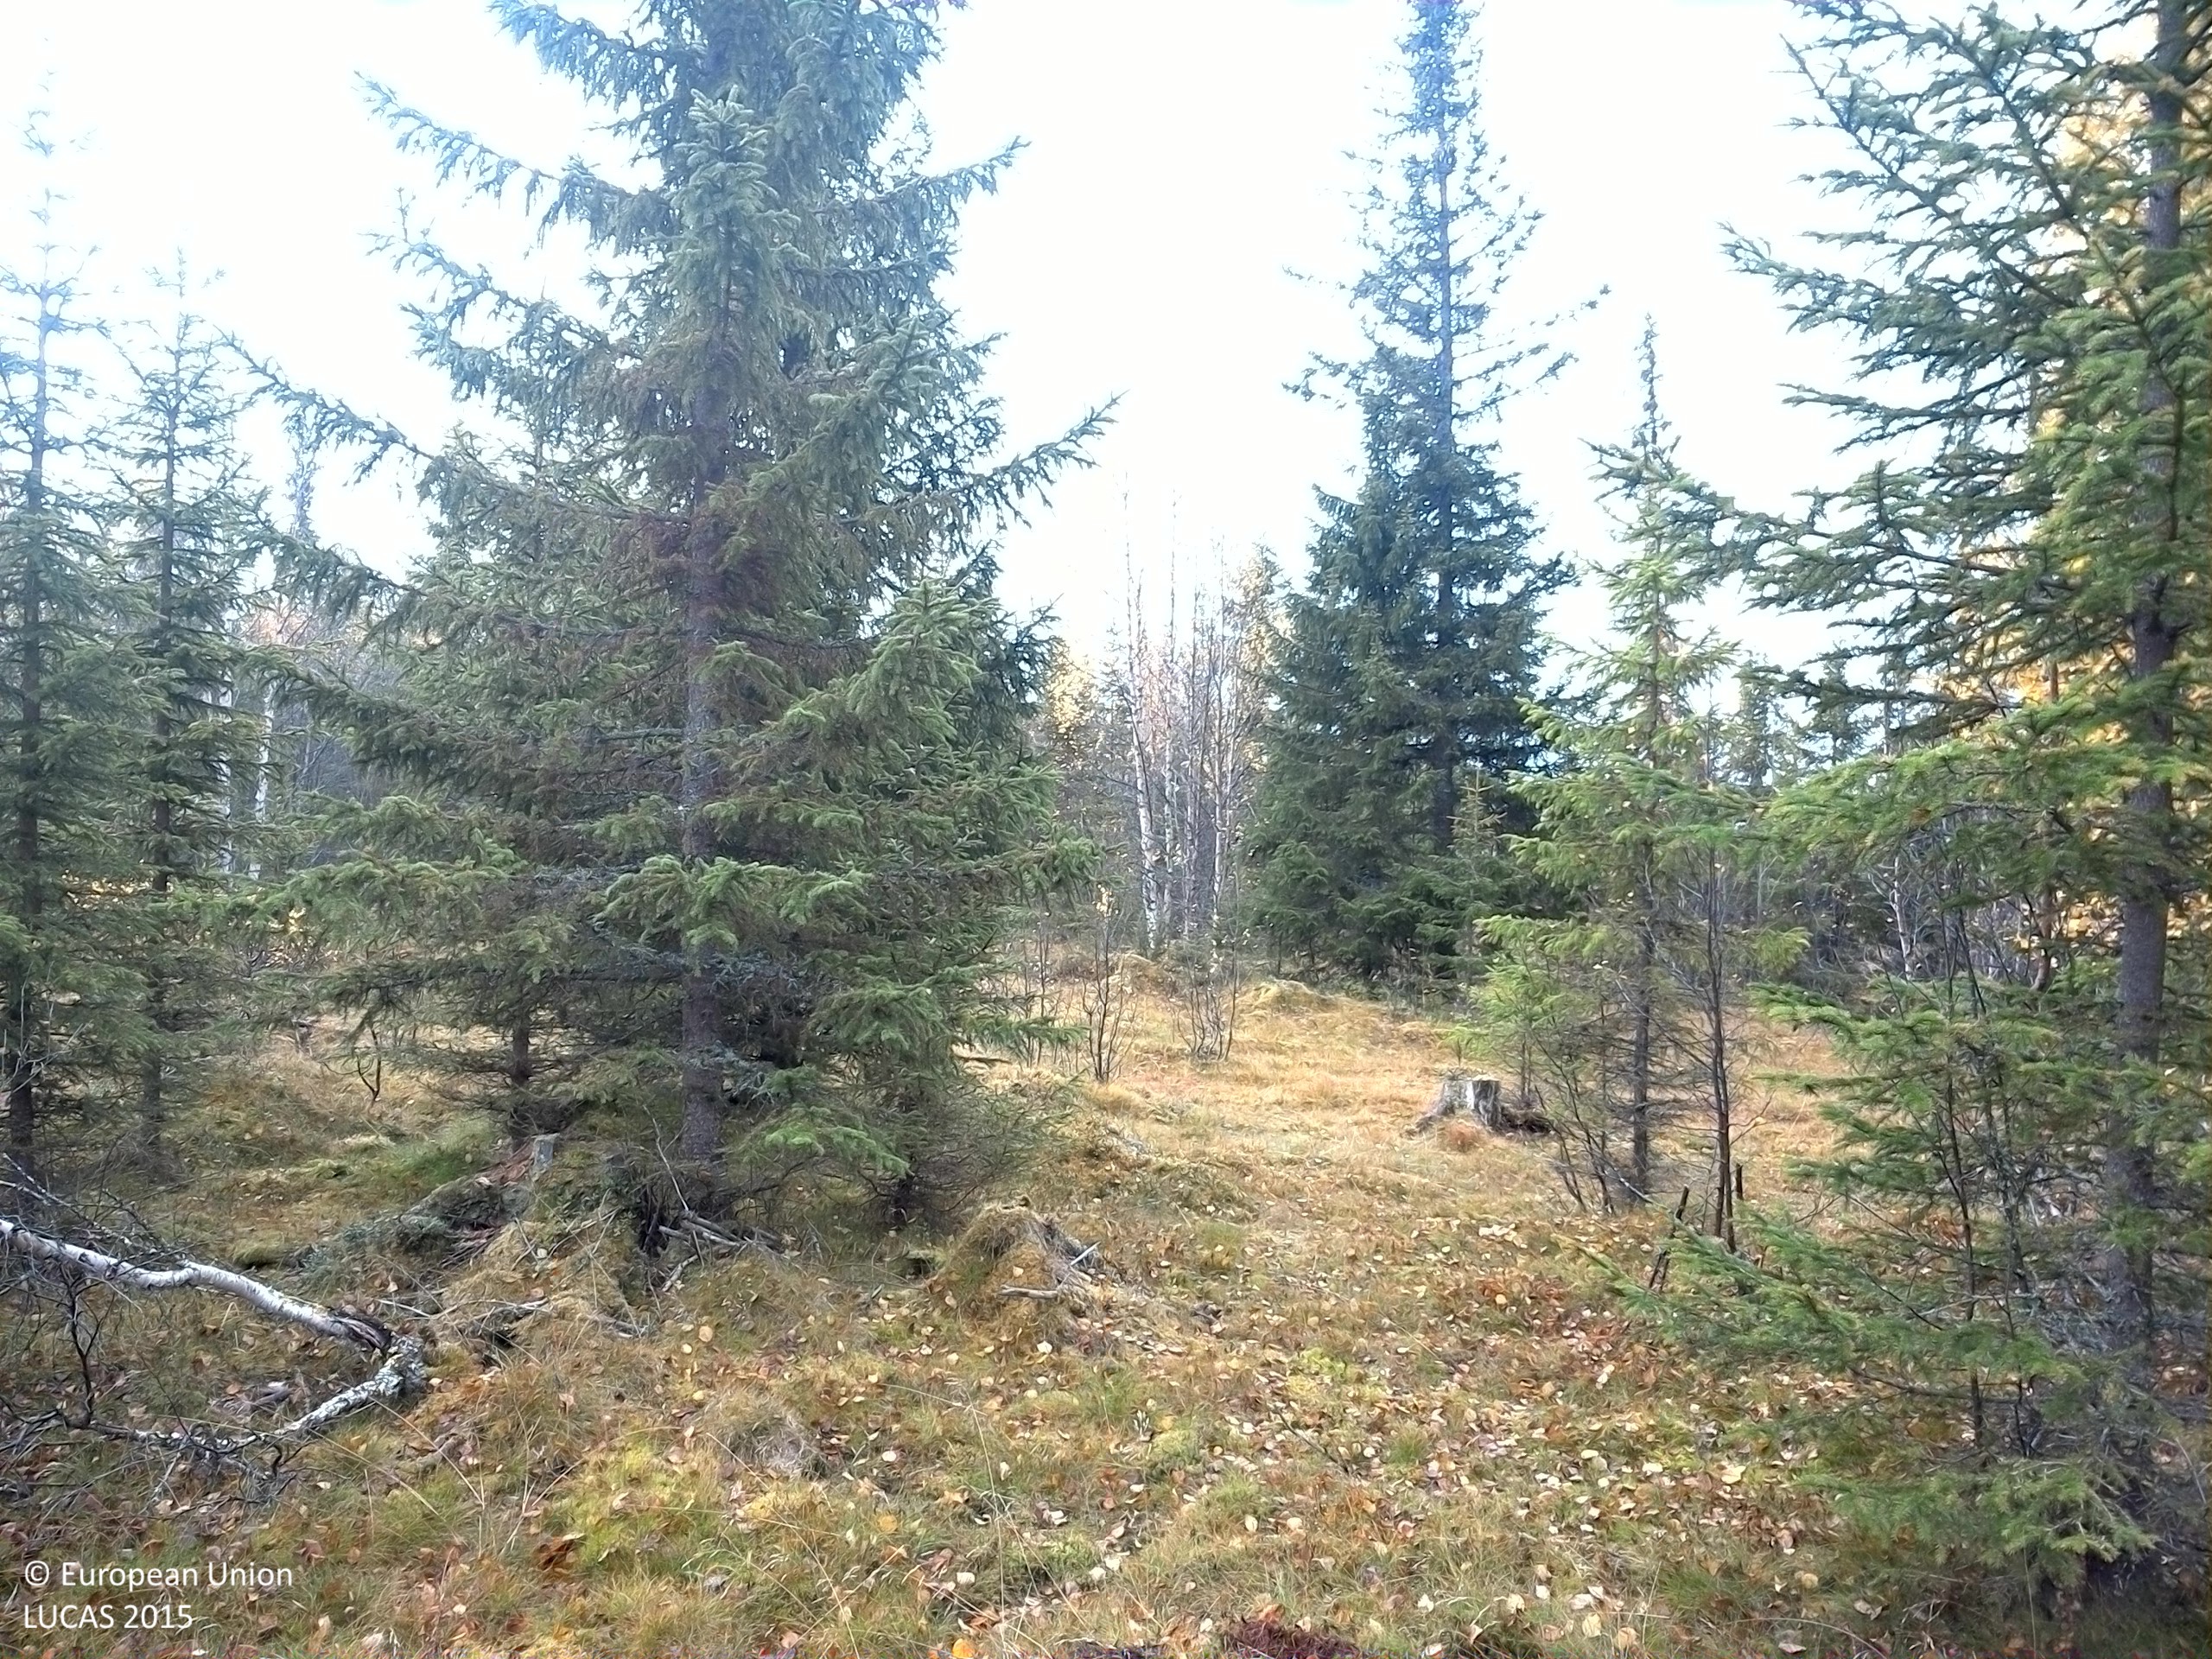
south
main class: Woodland
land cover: Spruce dominated mixed woodland
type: boreal forest
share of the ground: 25 - 50 %
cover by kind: coniferous forest trees 30 %, lichens and mosses 25 %, herbaceous plants 20 %, broadleaved forest trees 15 %, shrubs 10 %
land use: Forestry
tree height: > 5 m
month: October
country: SE
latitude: 64.3080
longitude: 15.8622
